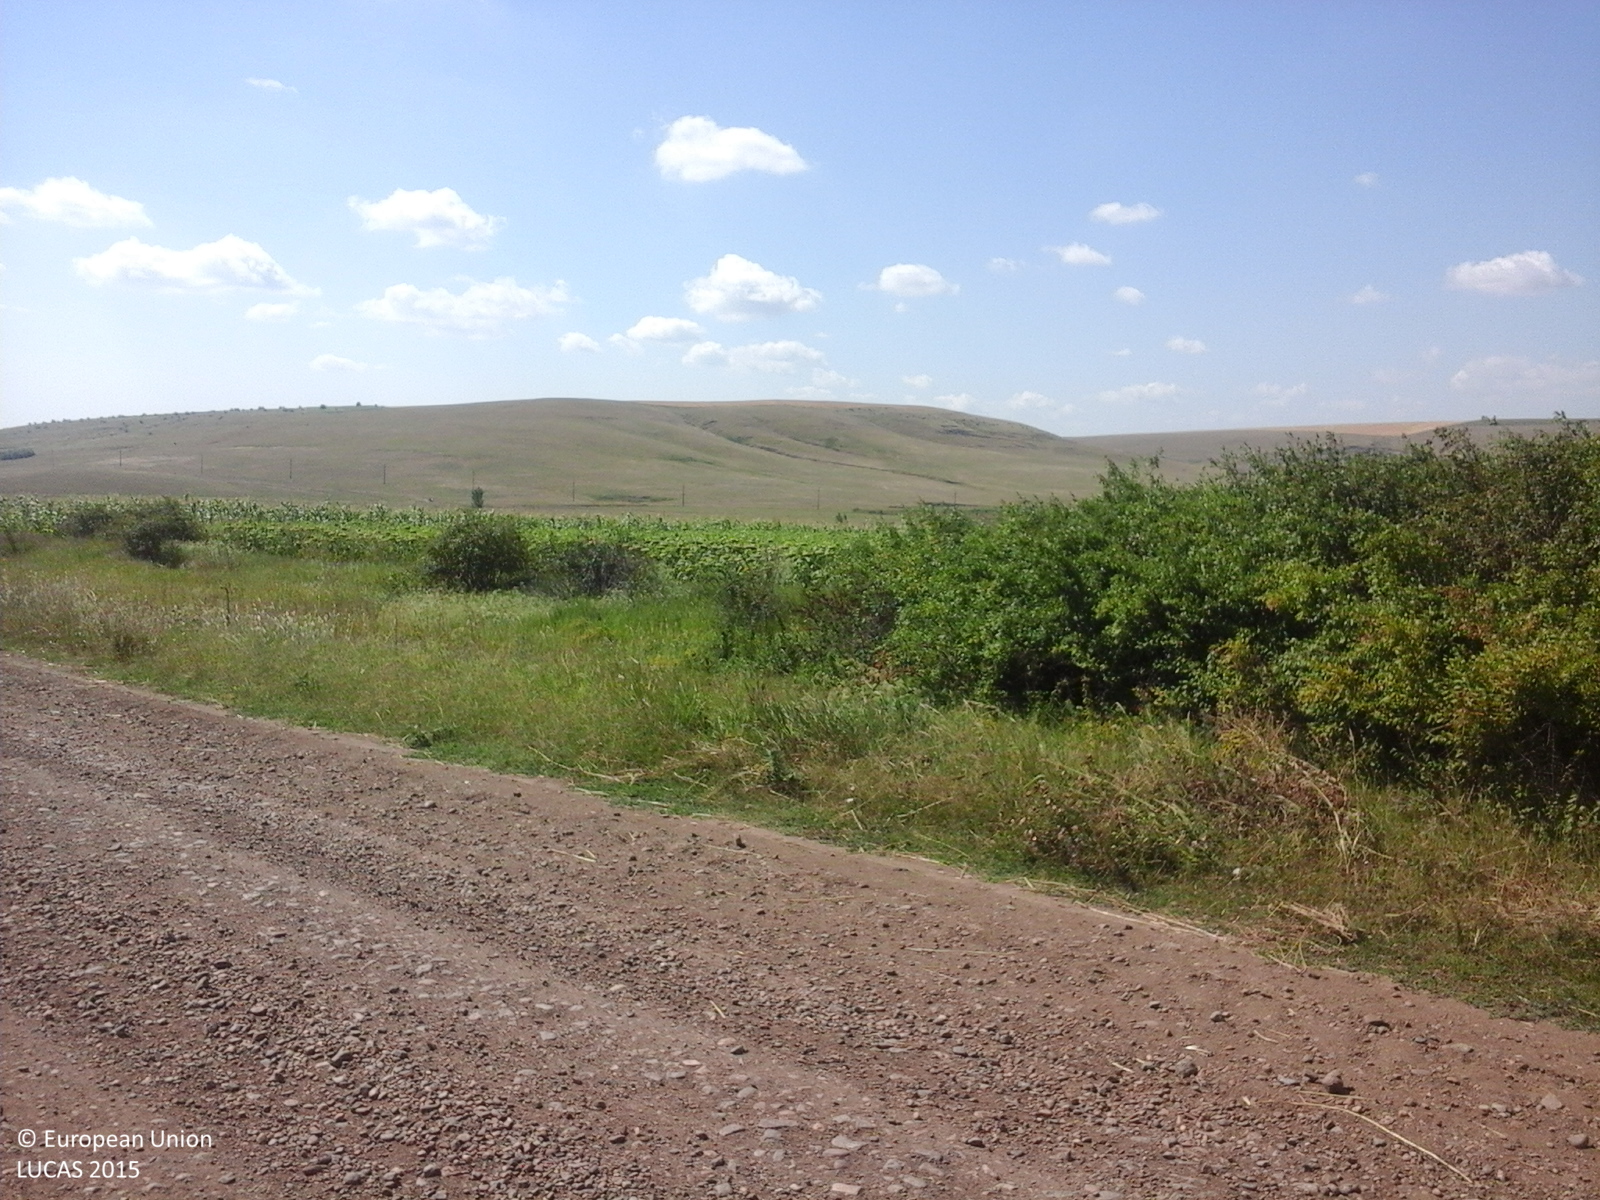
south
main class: Cropland
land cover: Sunflower
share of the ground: > 75 %
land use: Agriculture (excluding fallow land and kitchen gardens)
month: July
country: RO
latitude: 46.4096
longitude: 28.1206
